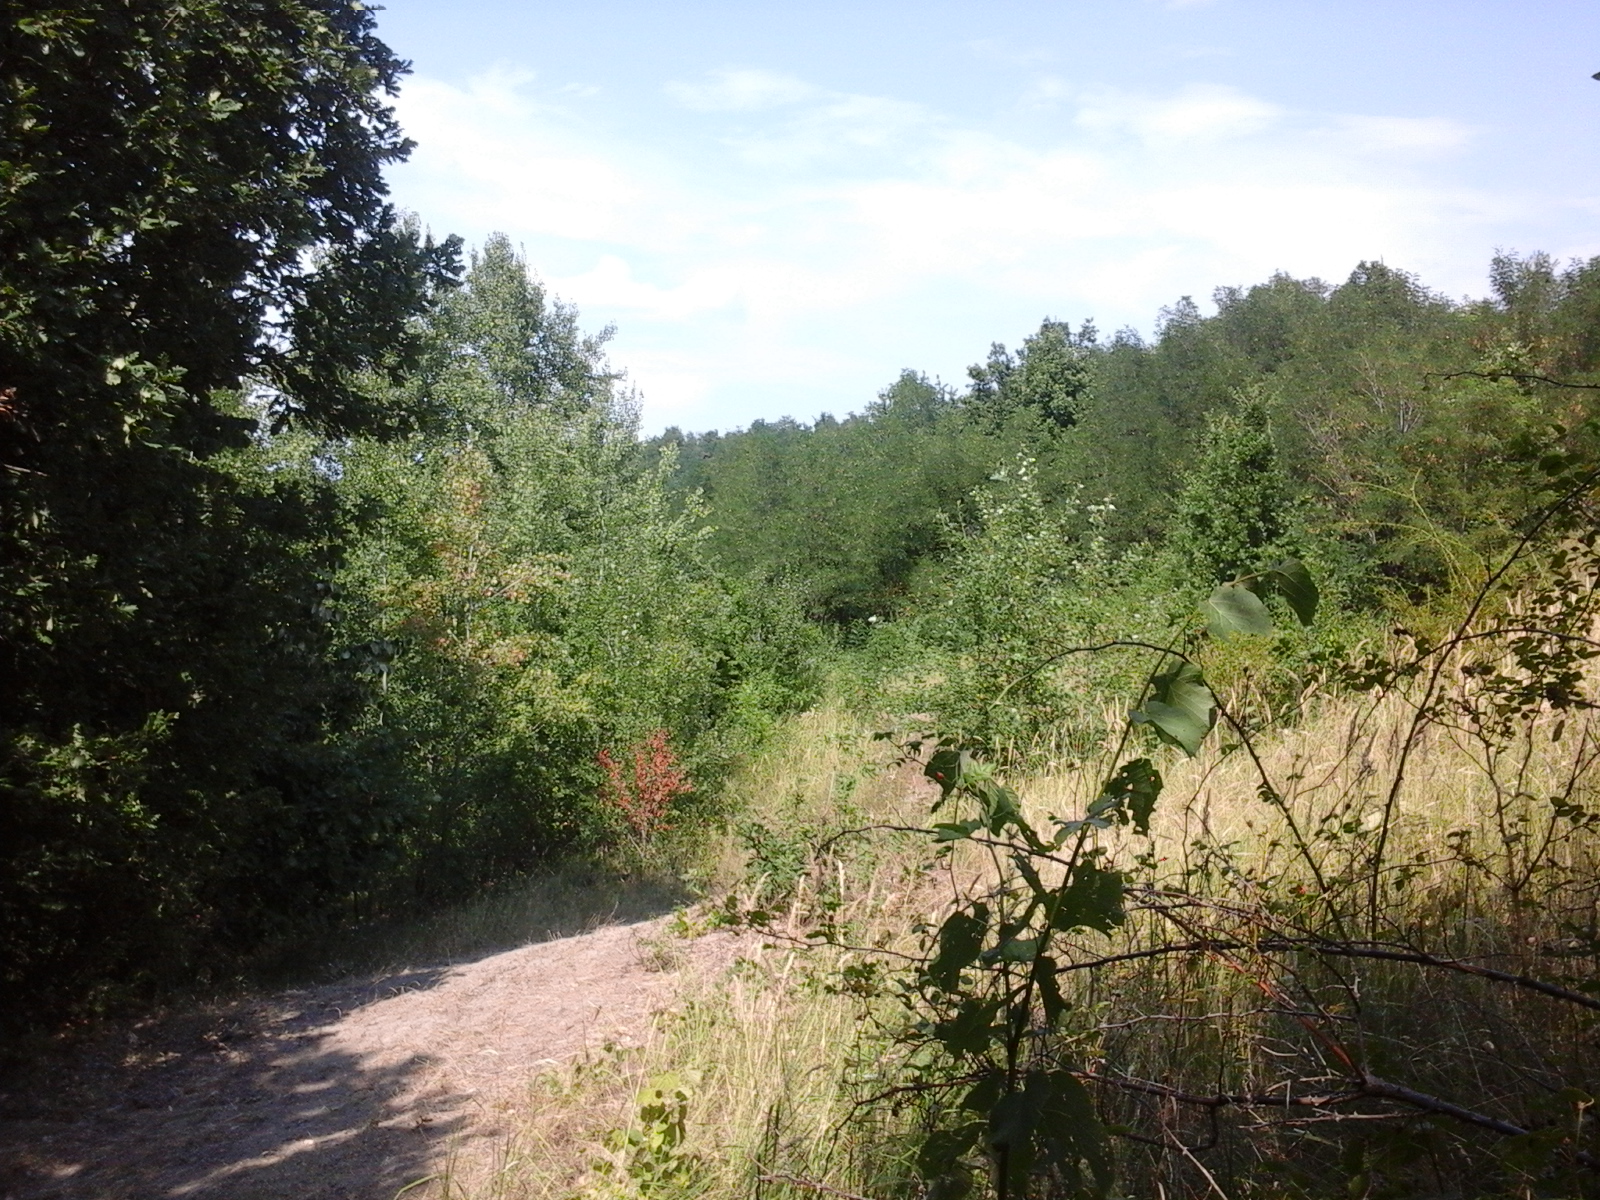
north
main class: Woodland
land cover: Broadleaved woodland
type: acidophilous oak and oak-birch forest
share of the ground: > 75 %
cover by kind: broadleaved forest trees 100 %
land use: Forestry
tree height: > 5 m
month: August
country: RO
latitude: 44.8899
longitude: 23.9025
